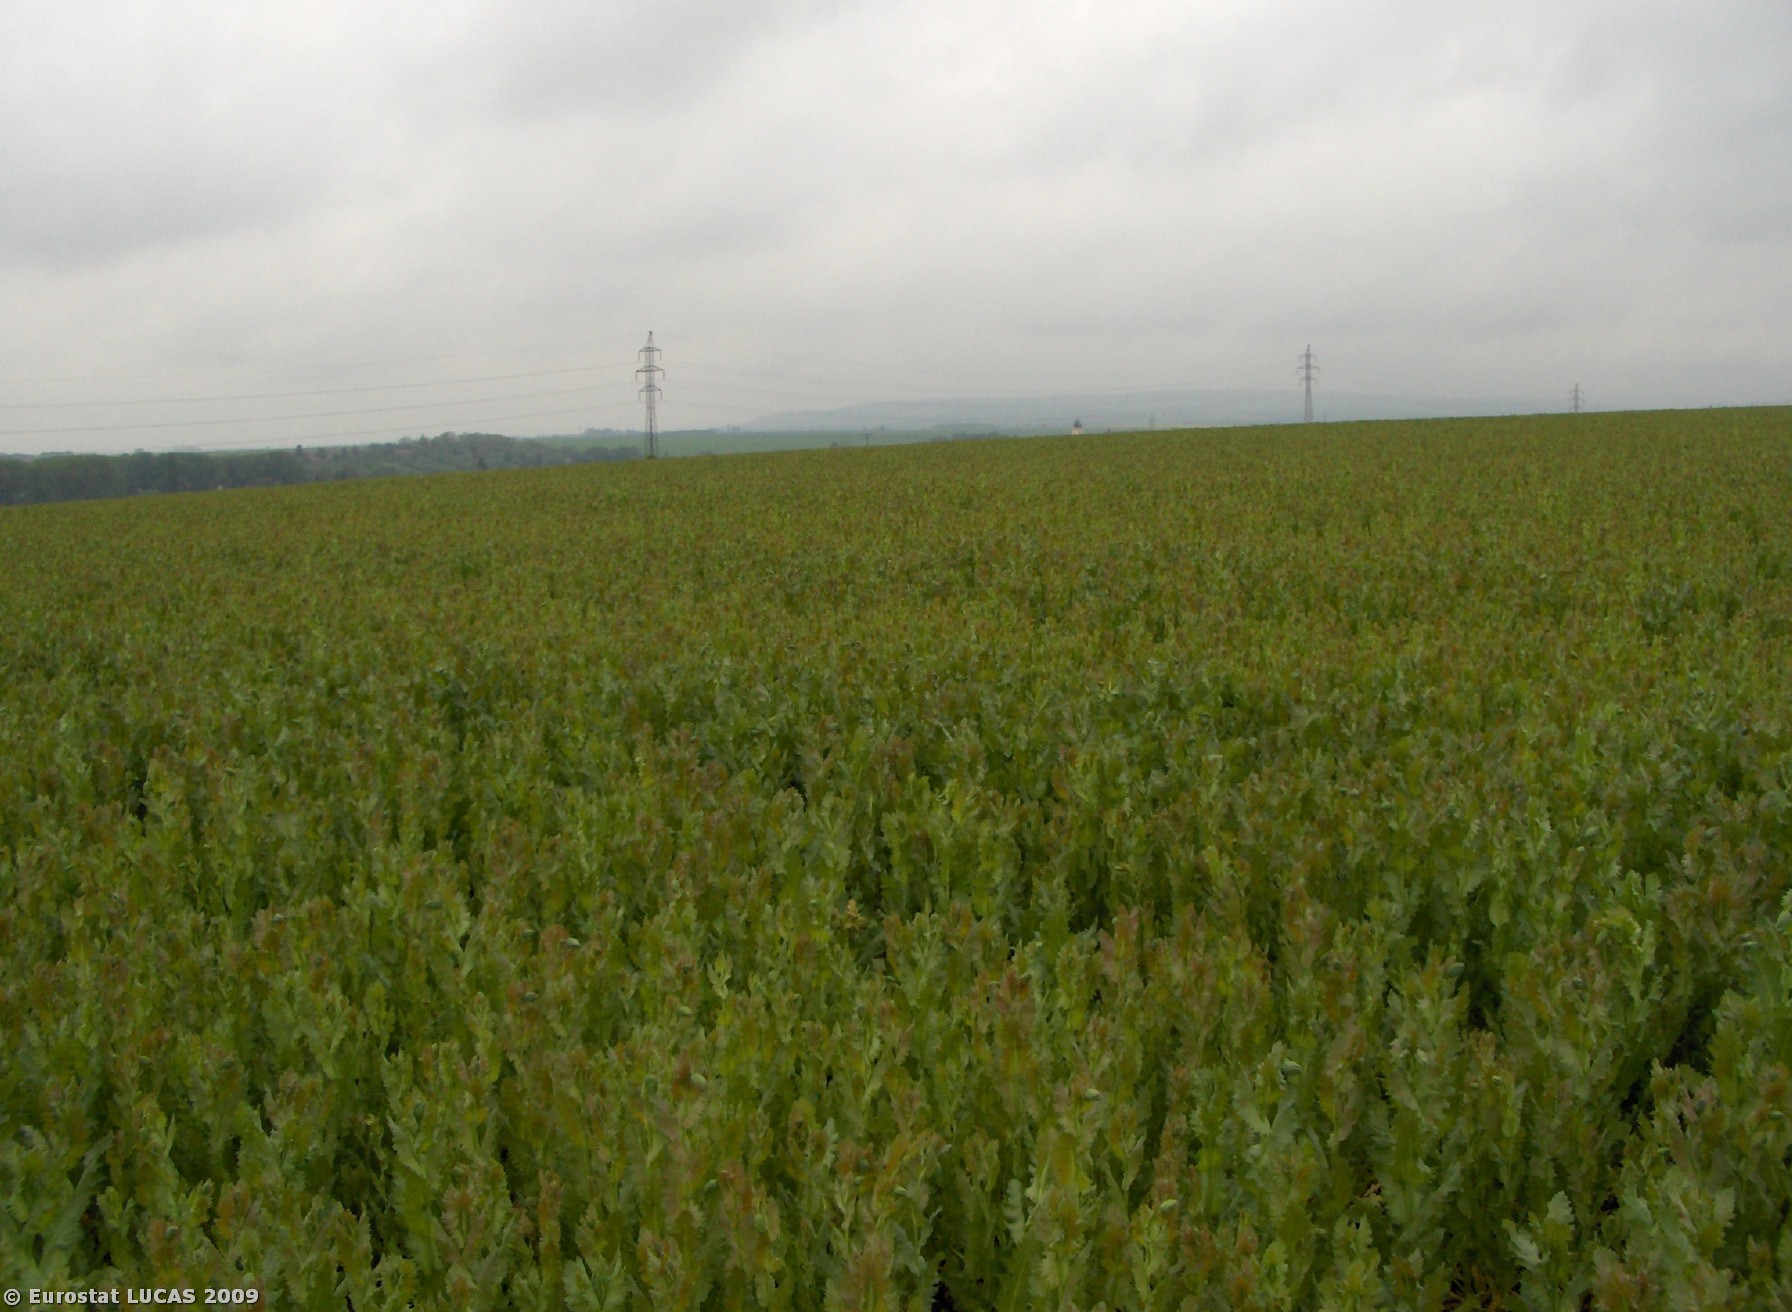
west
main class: Cropland
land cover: Other fibre and oleaginous crops
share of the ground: > 75 %
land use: Agriculture (excluding fallow land and kitchen gardens)
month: May
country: CZ
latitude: 49.3634
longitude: 17.1565
